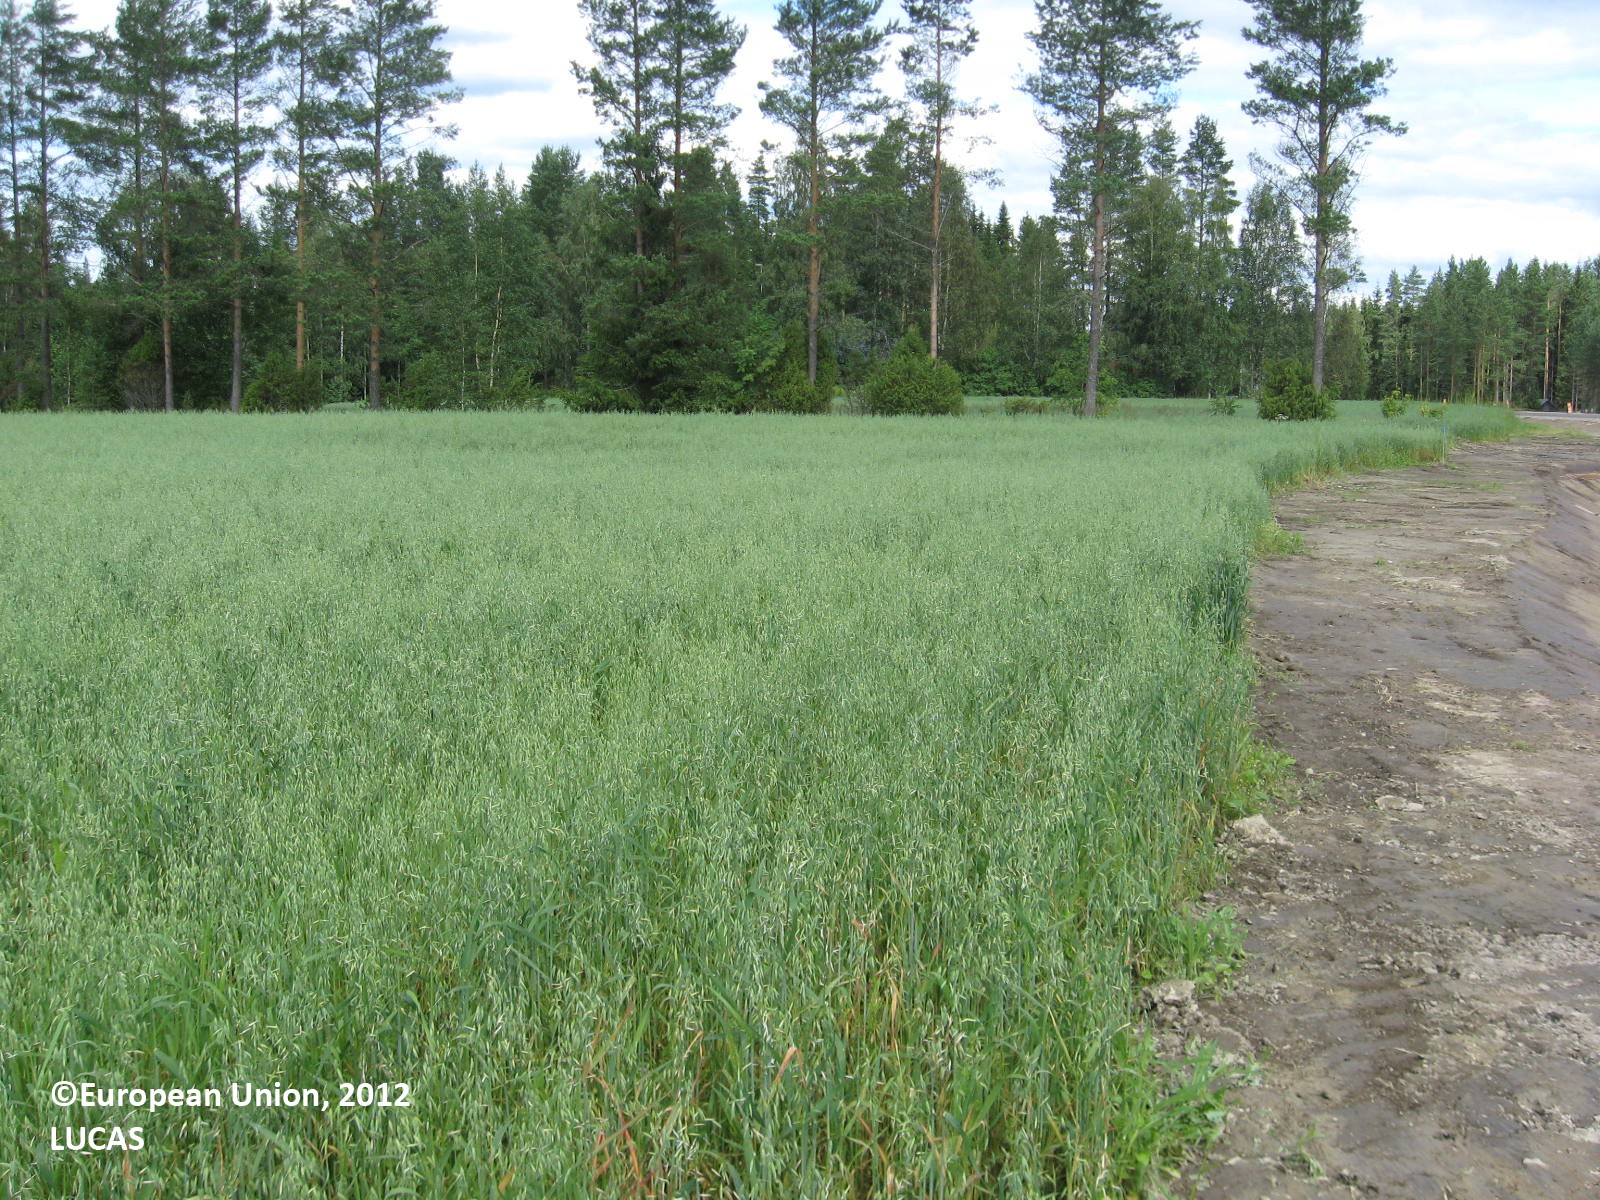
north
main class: Cropland
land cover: Oats
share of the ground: > 75 %
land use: Agriculture (excluding fallow land and kitchen gardens)
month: July
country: FI
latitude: 62.0206
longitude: 22.2267
